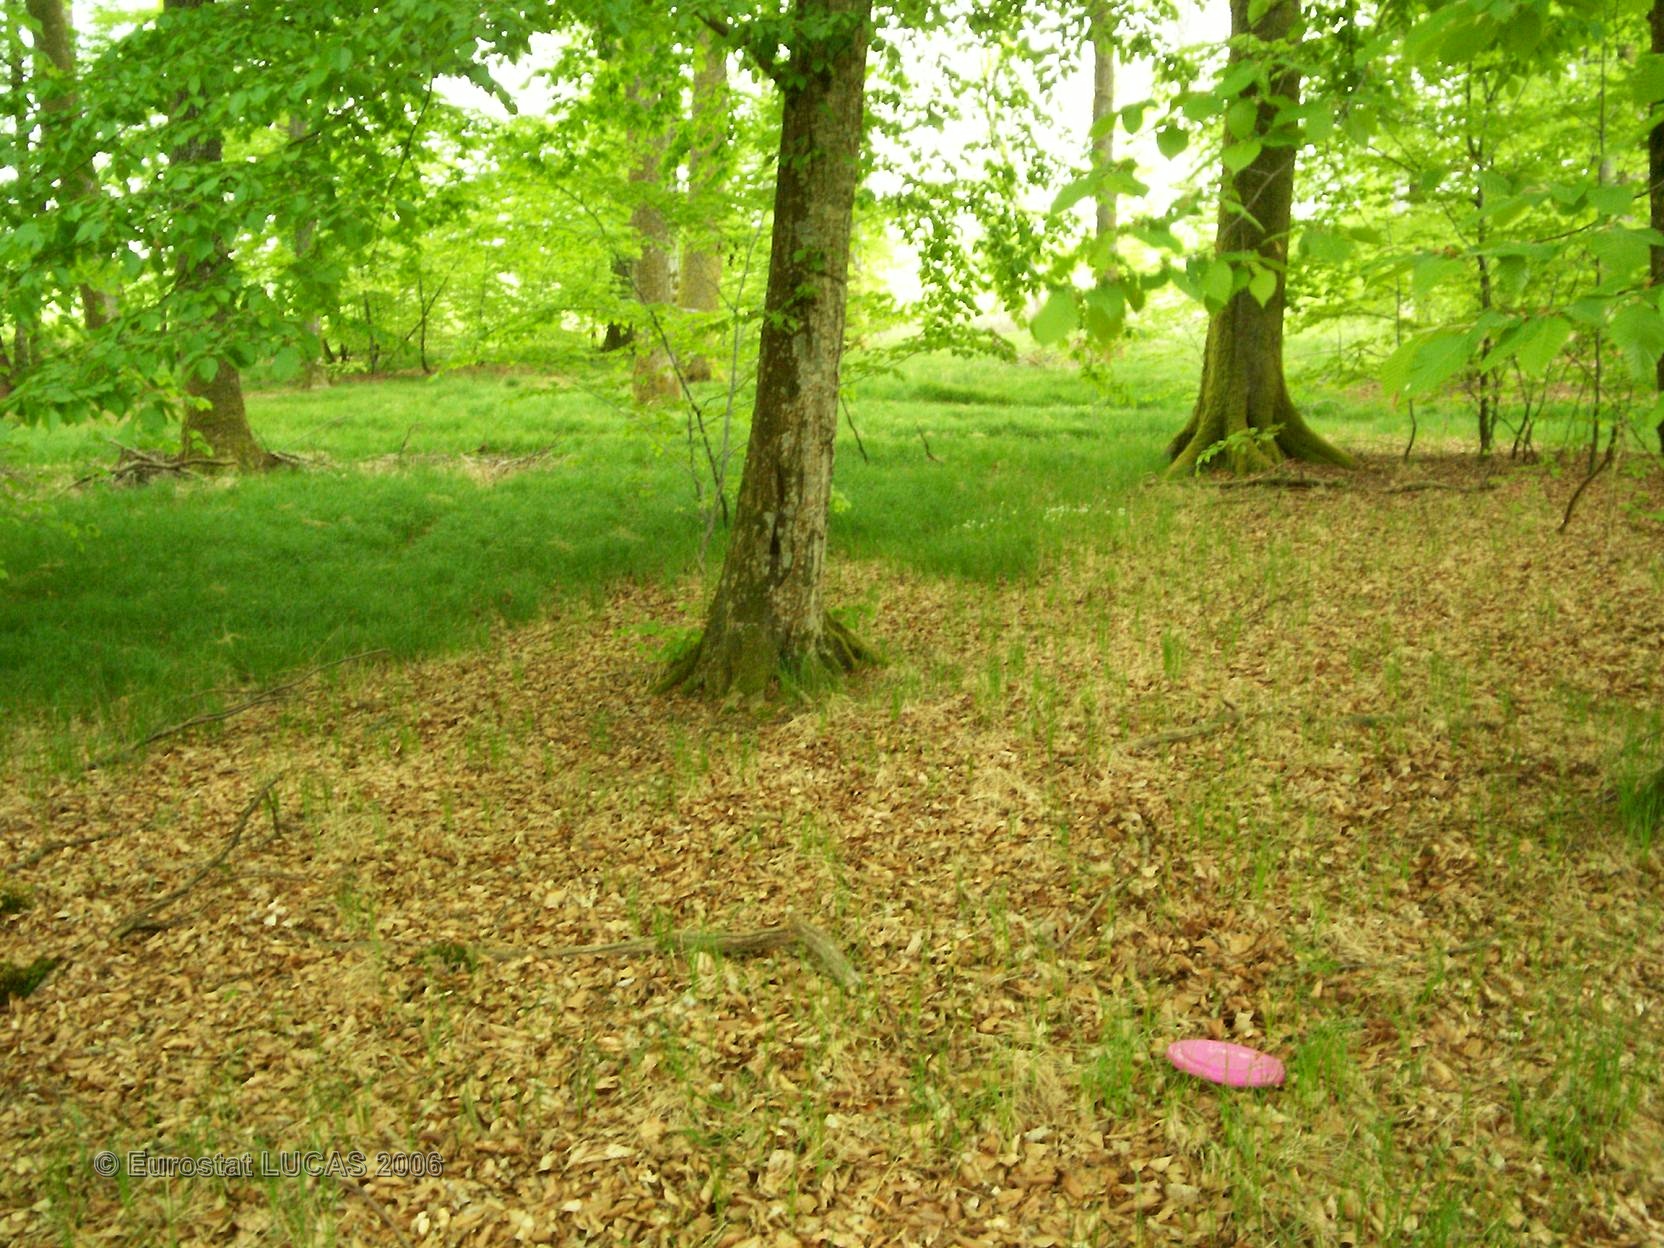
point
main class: Woodland
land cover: Broadleaved forest
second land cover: Grassland with sparse tree/shrub cover
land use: Forestry
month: May
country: FR
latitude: 47.7354
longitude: 7.1078
